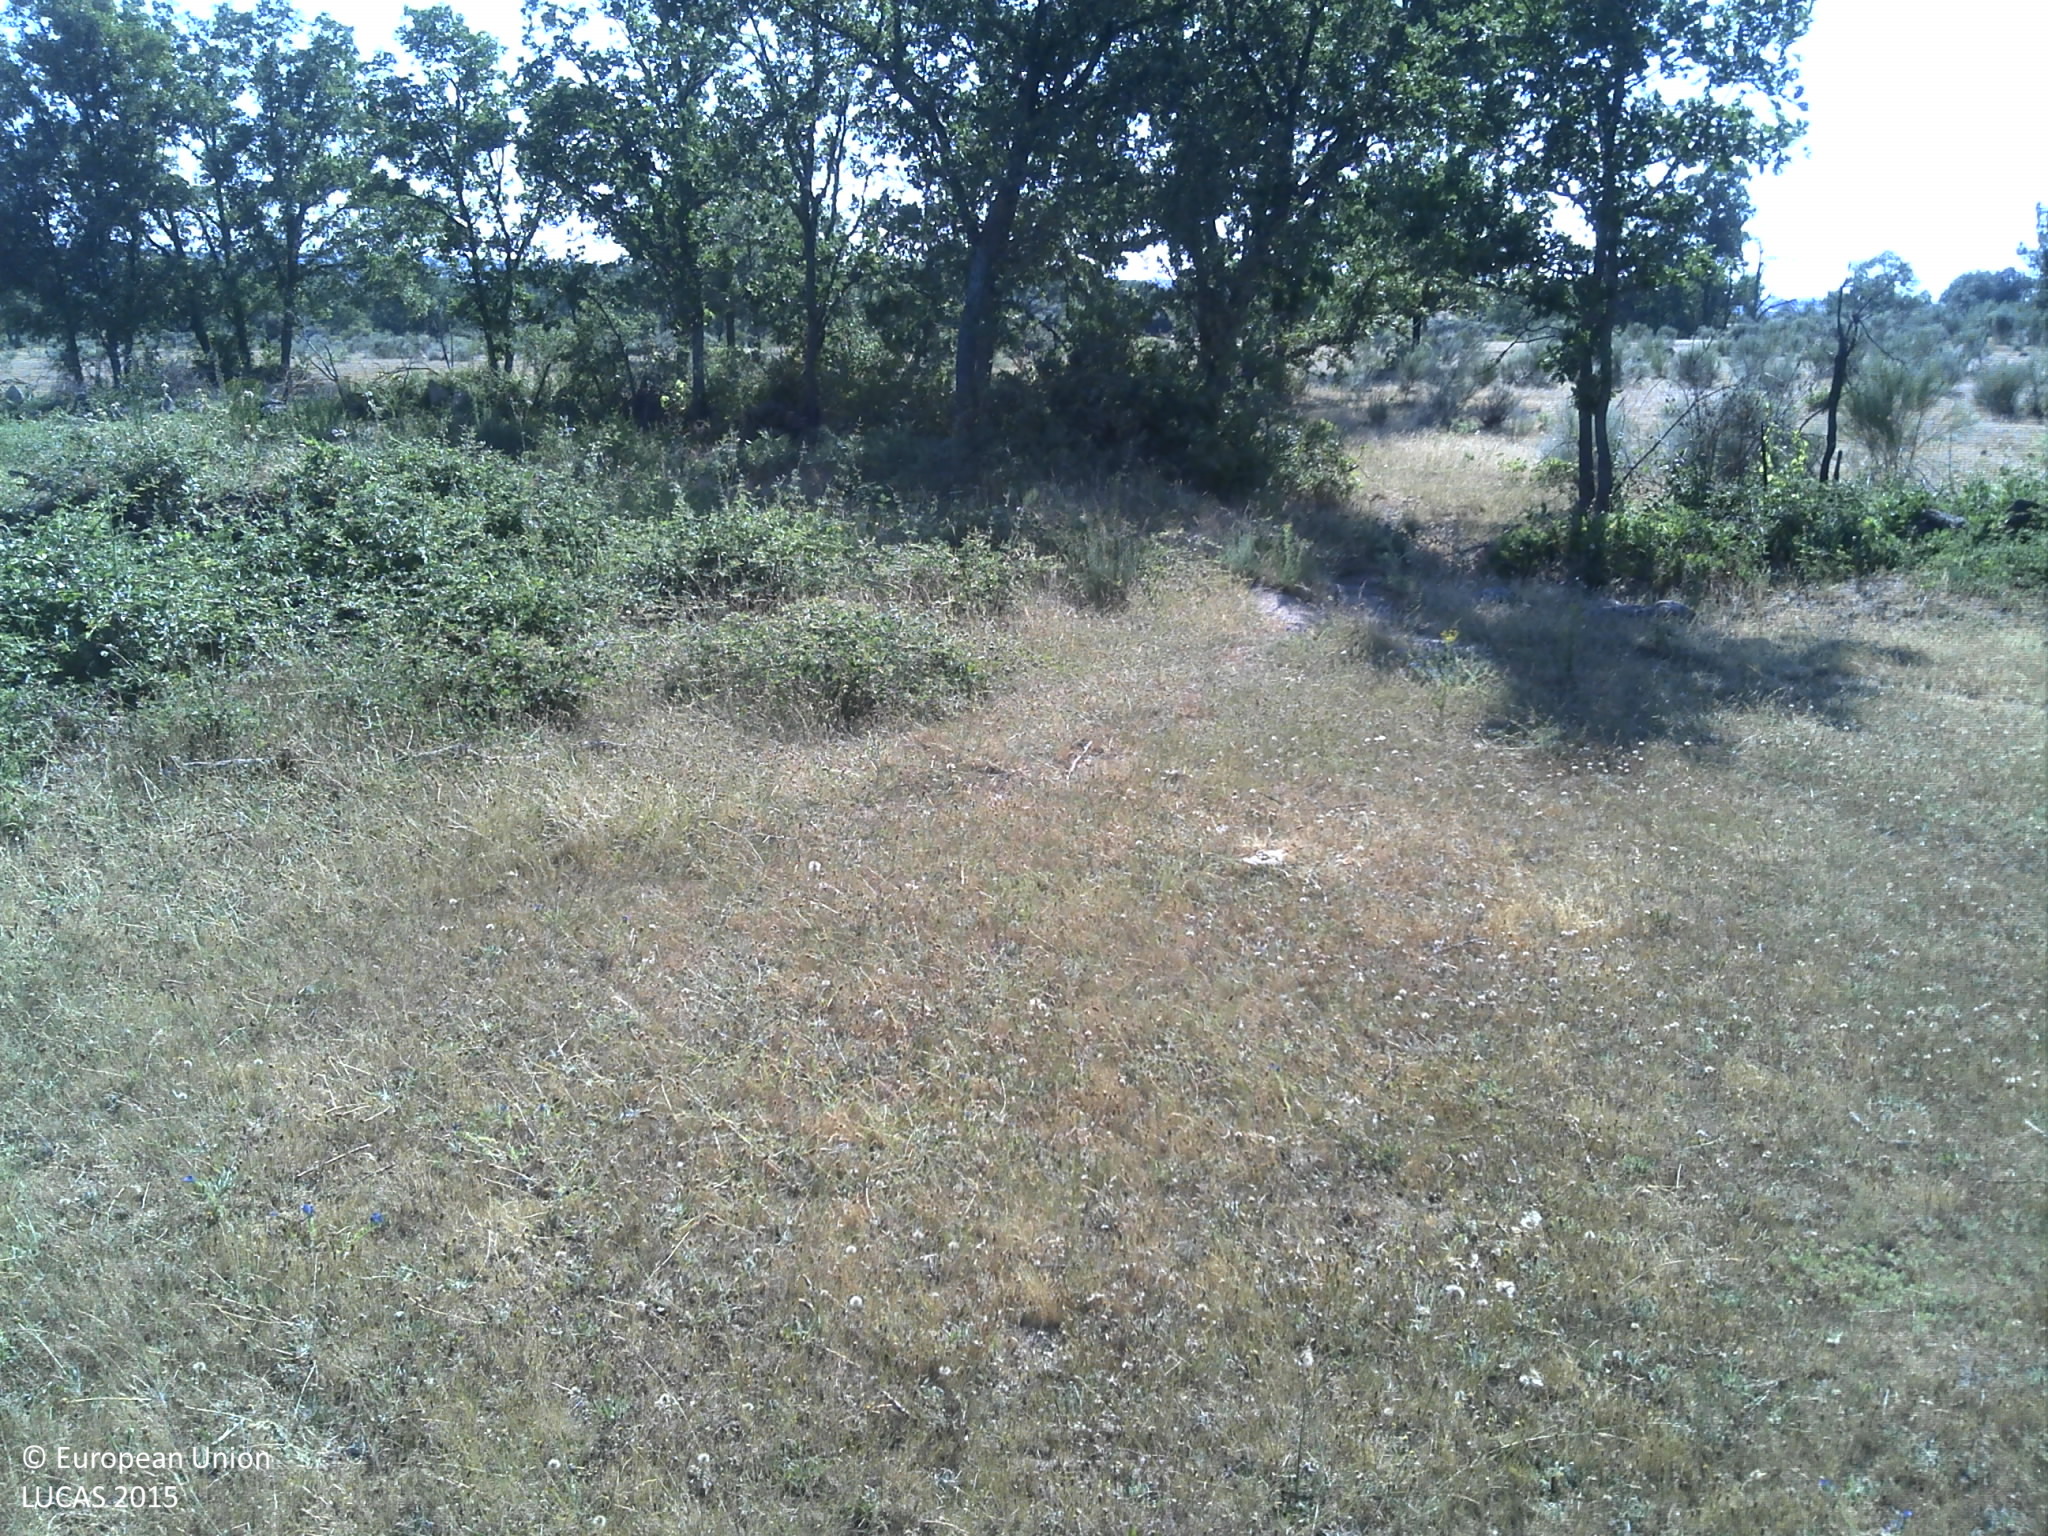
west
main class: Grassland
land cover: Grassland without tree/shrub cover
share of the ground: > 75 %
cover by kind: herbaceous plants 90 %, unconsolidated bare surface 10 %
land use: Agriculture (excluding fallow land and kitchen gardens)
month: June
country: PT
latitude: 40.7893
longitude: -6.8451
